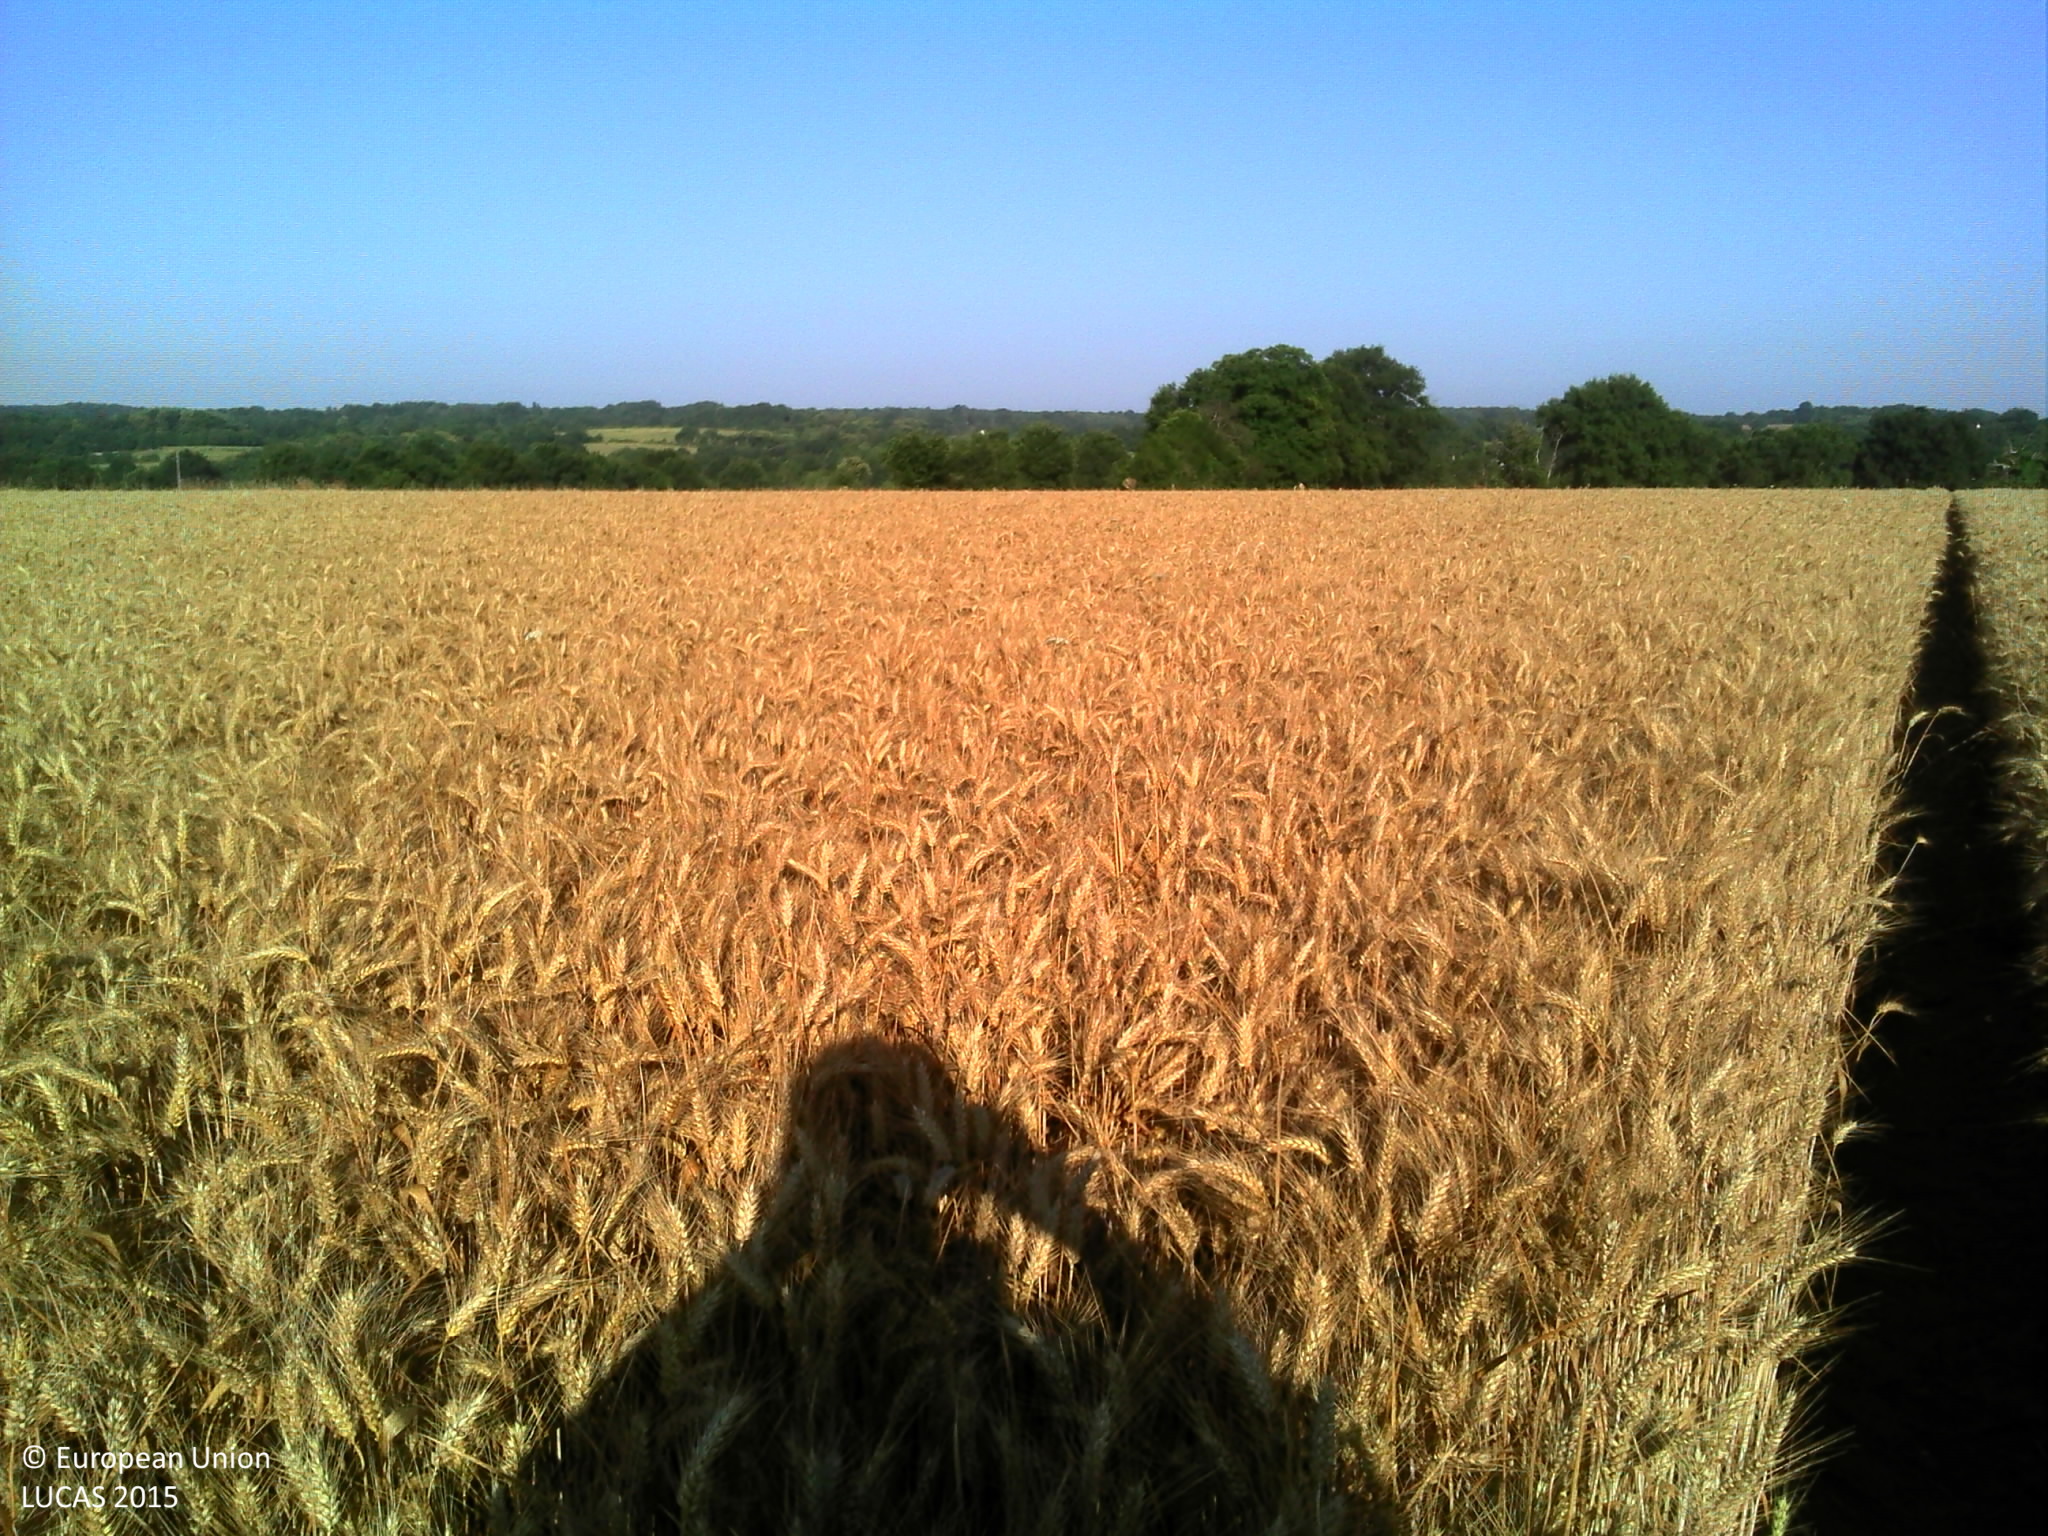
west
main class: Cropland
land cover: Common wheat
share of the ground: > 75 %
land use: Agriculture (excluding fallow land and kitchen gardens)
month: July
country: FR
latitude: 47.3421
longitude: -1.5444
